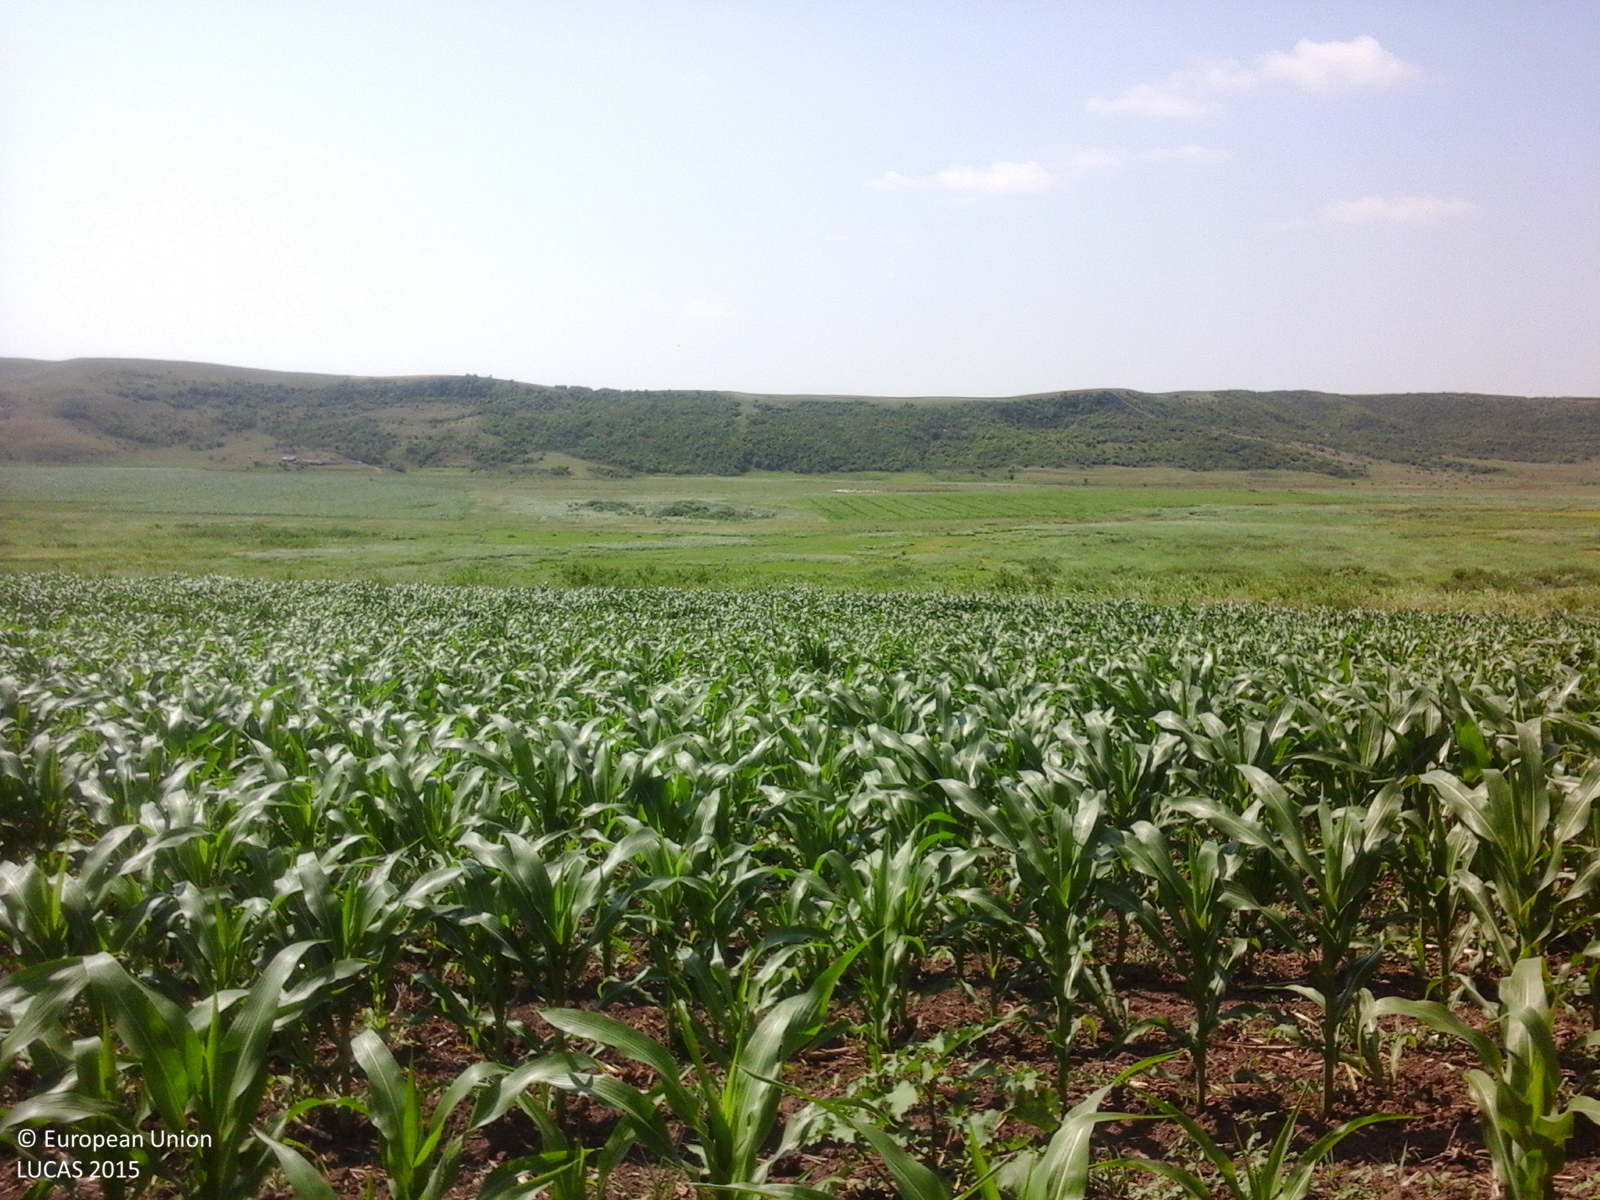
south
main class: Cropland
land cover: Maize
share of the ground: 50 - 75 %
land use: Agriculture (excluding fallow land and kitchen gardens)
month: June
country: RO
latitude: 46.7787
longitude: 27.0067
